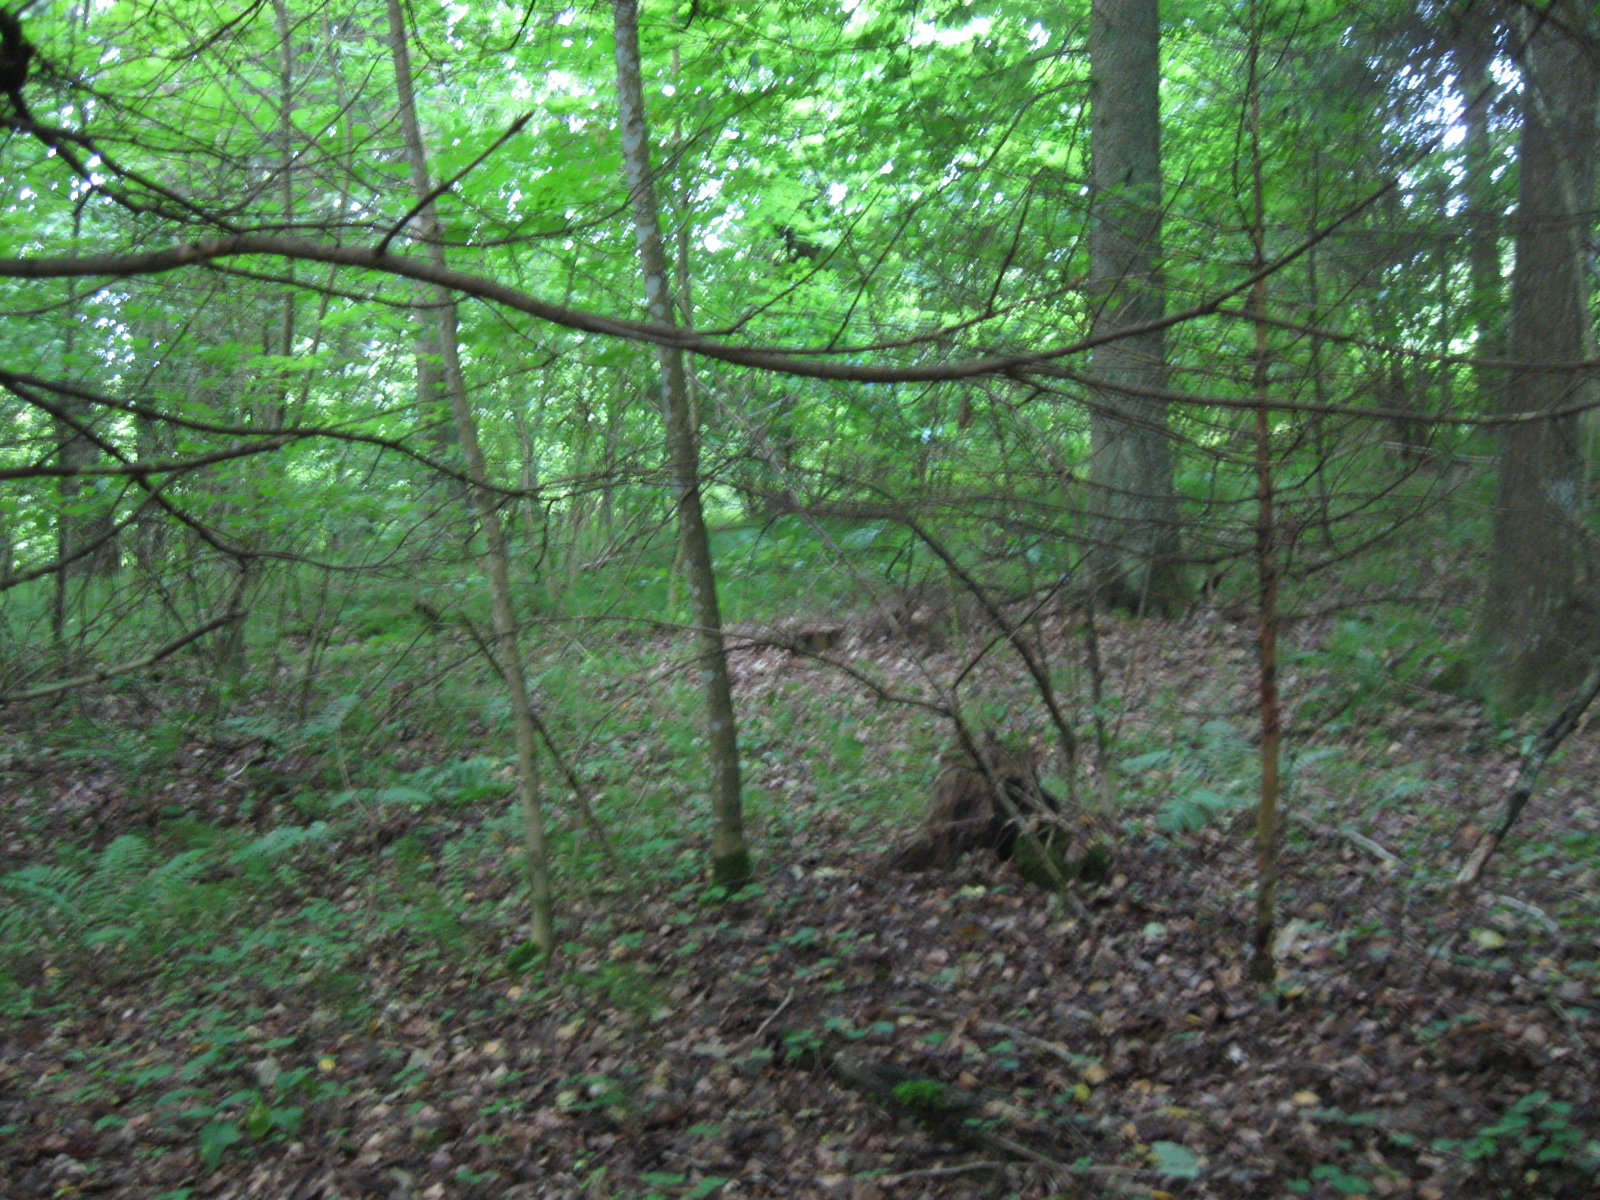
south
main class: Woodland
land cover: Other mixed woodland
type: hemiboreal forest and nemoral coniferous forest and mixed broadleaved-coniferous forest
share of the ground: > 75 %
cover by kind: broadleaved forest trees 65 %, coniferous forest trees 30 %, herbaceous plants 5 %
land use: Forestry
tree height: > 5 m
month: July
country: LT
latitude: 54.3602
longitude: 24.2714
